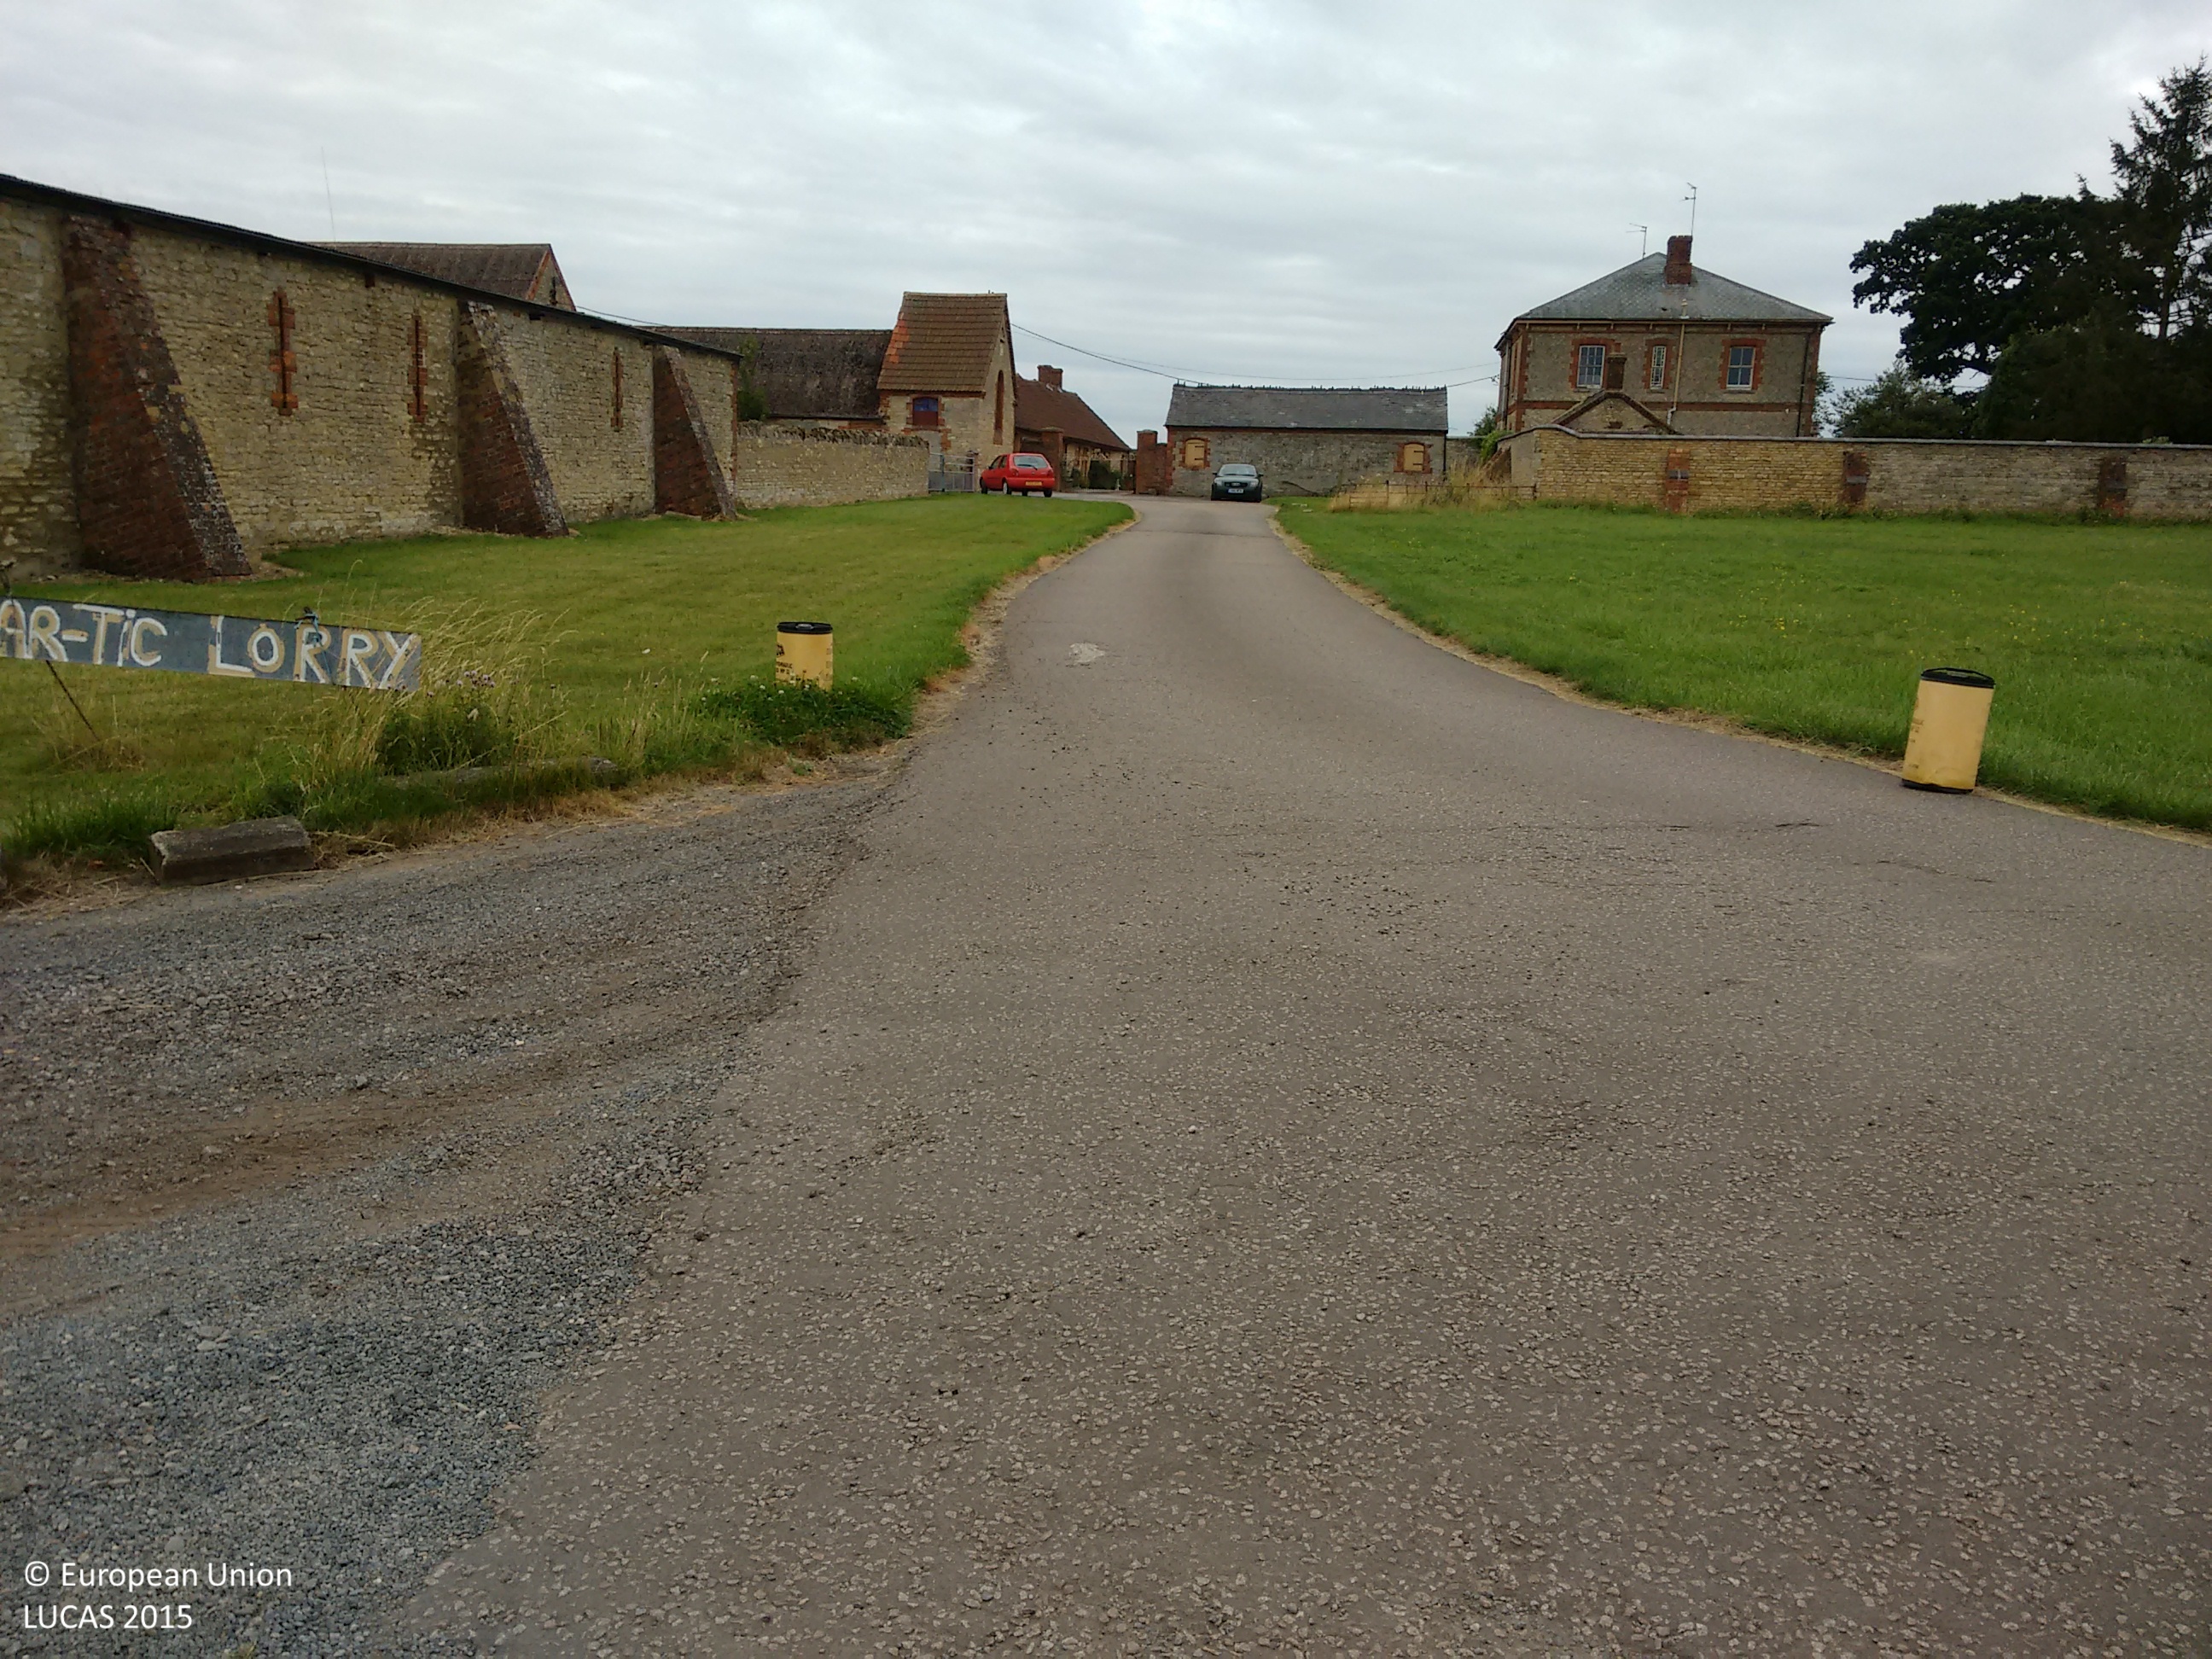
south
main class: Grassland
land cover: Grassland without tree/shrub cover
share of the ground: > 75 %
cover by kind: herbaceous plants 100 %
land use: Agriculture (excluding fallow land and kitchen gardens)
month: August
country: GB
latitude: 52.2028
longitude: -0.6779
